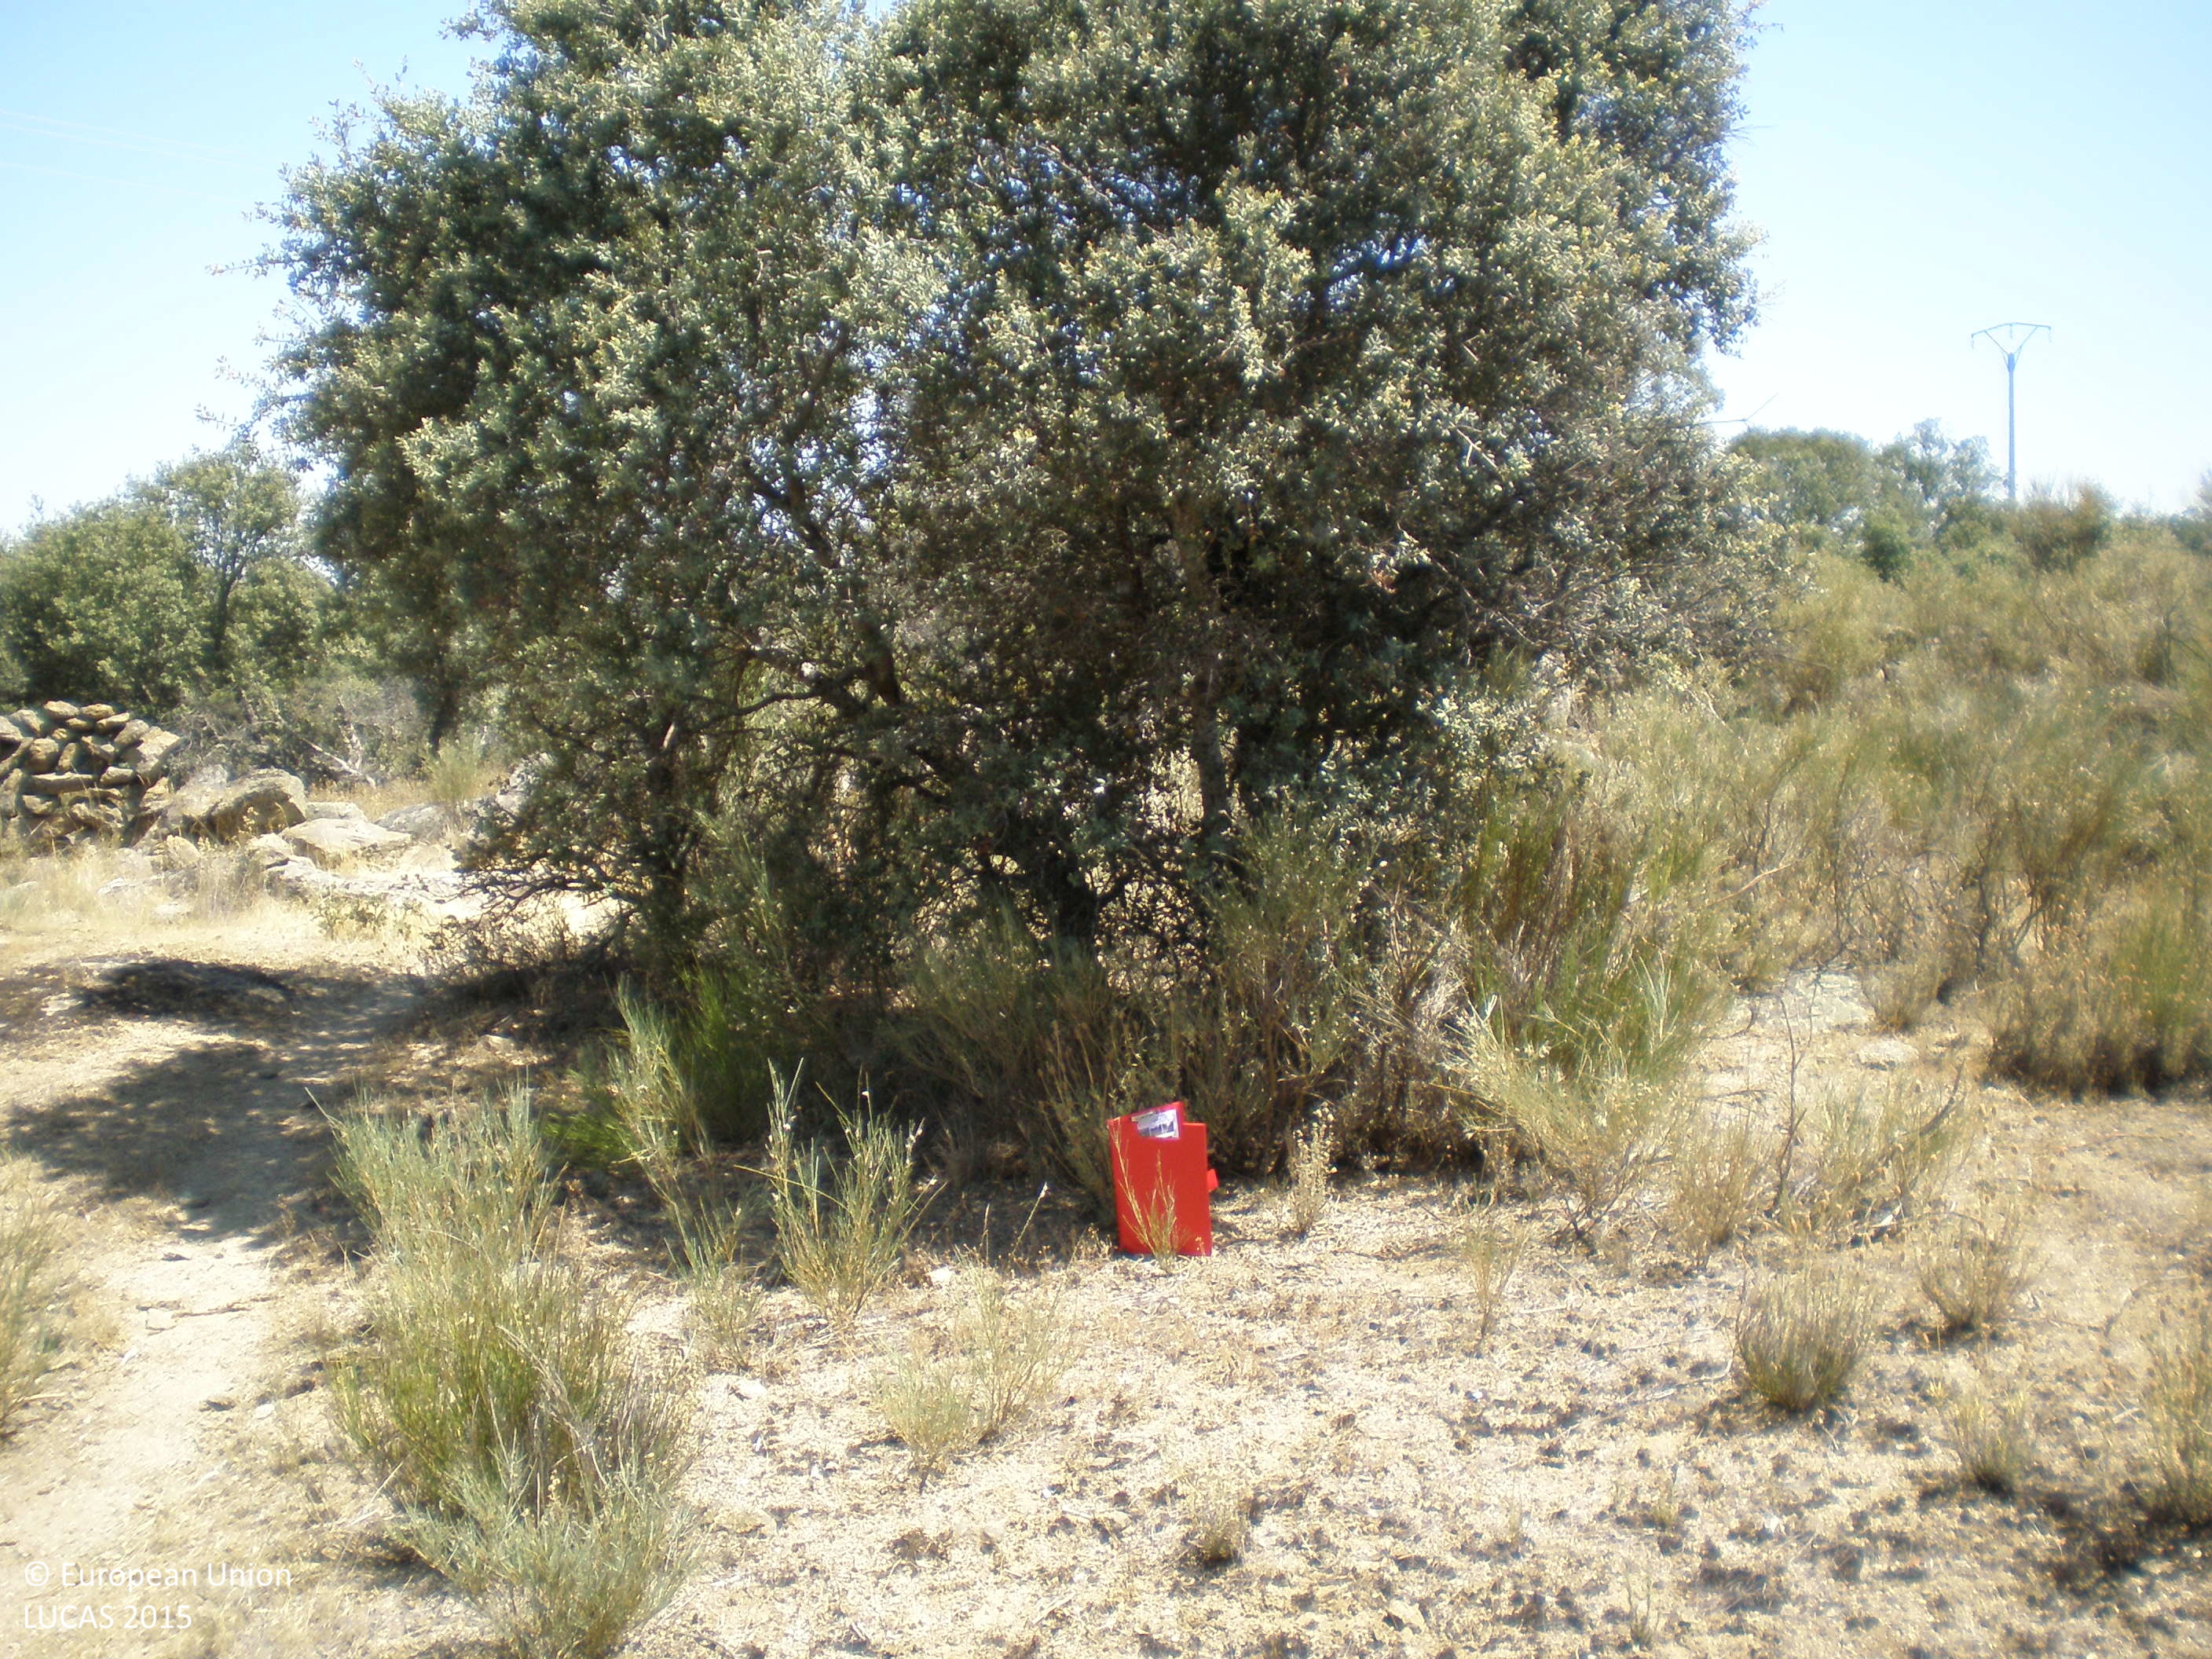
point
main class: Woodland
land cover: Broadleaved woodland
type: broadleaved evergreen forest
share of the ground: 25 - 50 %
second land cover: Grassland without tree/shrub cover
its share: 50 - 75 %
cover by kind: herbaceous plants 70 %, broadleaved forest trees 30 %
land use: Forestry
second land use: Agriculture (excluding fallow land and kitchen gardens)
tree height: > 5 m
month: July
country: ES
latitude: 40.4211
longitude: -5.5179
